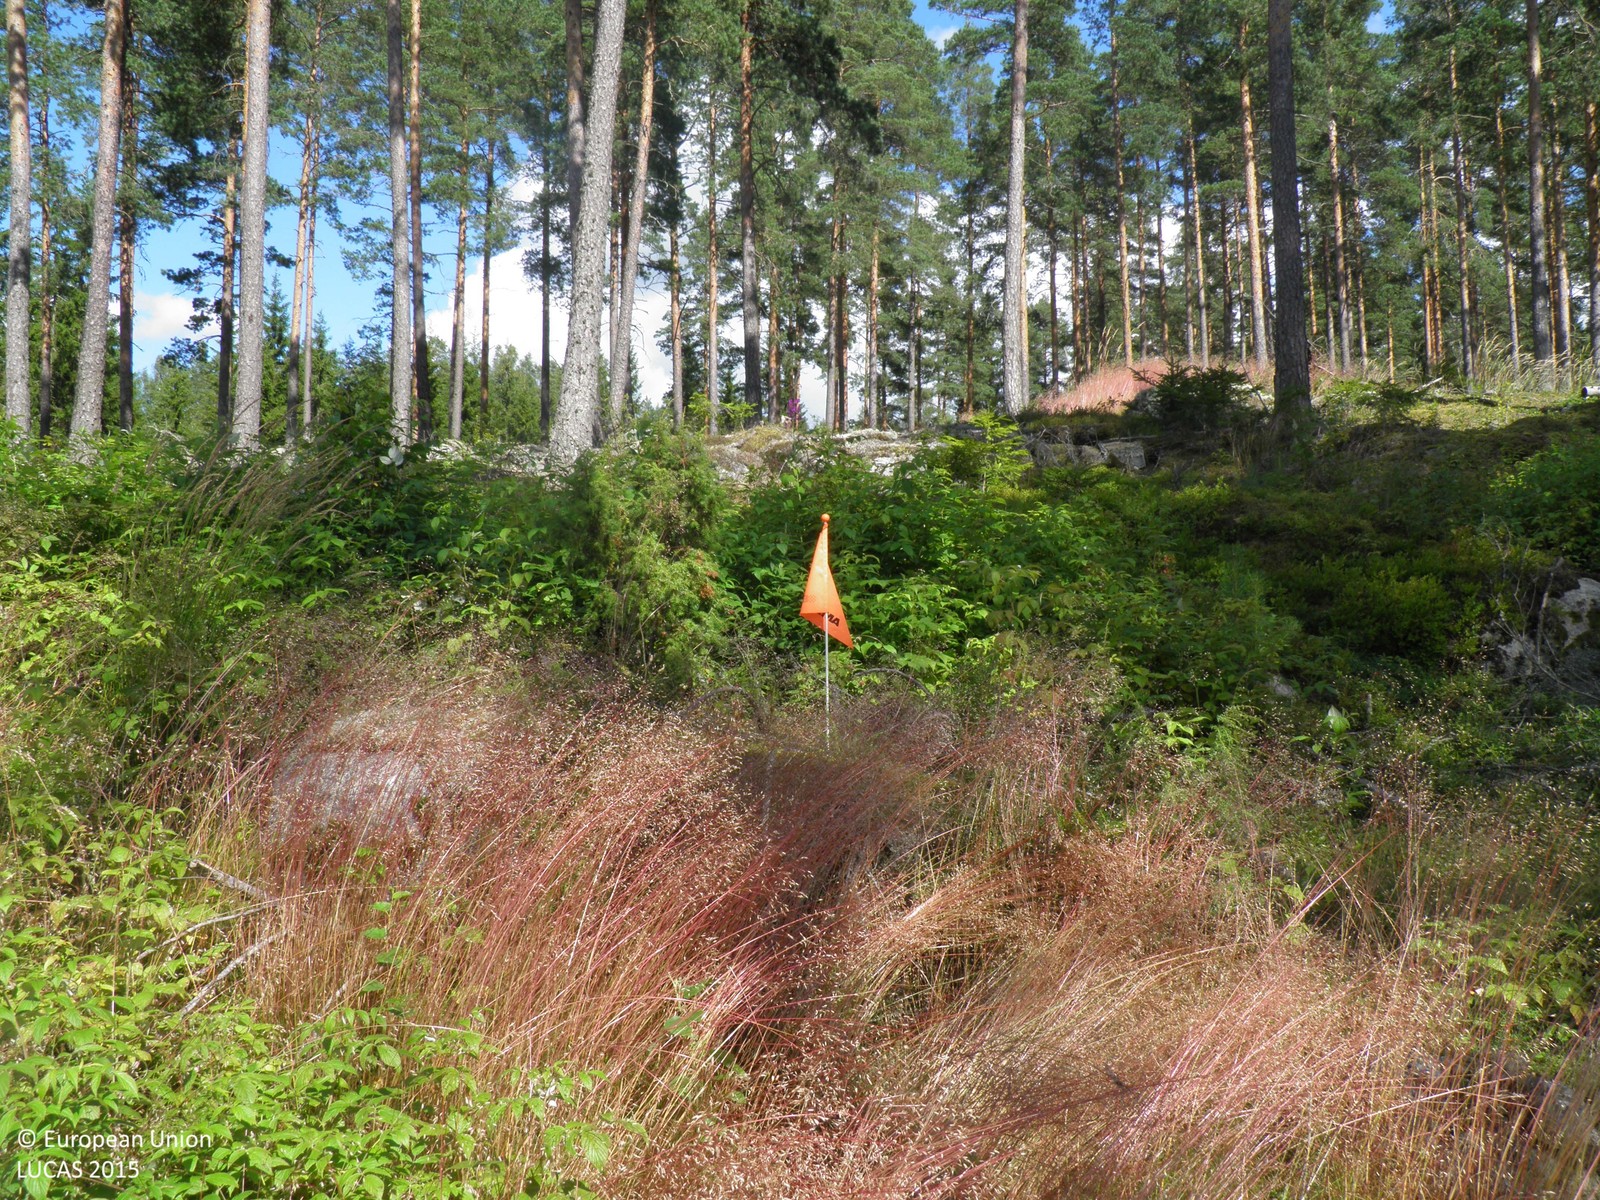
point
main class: Woodland
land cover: Pine dominated coniferous woodland
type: hemiboreal forest and nemoral coniferous forest and mixed broadleaved-coniferous forest
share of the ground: 25 - 50 %
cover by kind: shrubs 30 %, coniferous forest trees 25 %, lichens and mosses 25 %, herbaceous plants 20 %
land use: Forestry
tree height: > 5 m
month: August
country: FI
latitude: 60.9426
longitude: 23.0516
